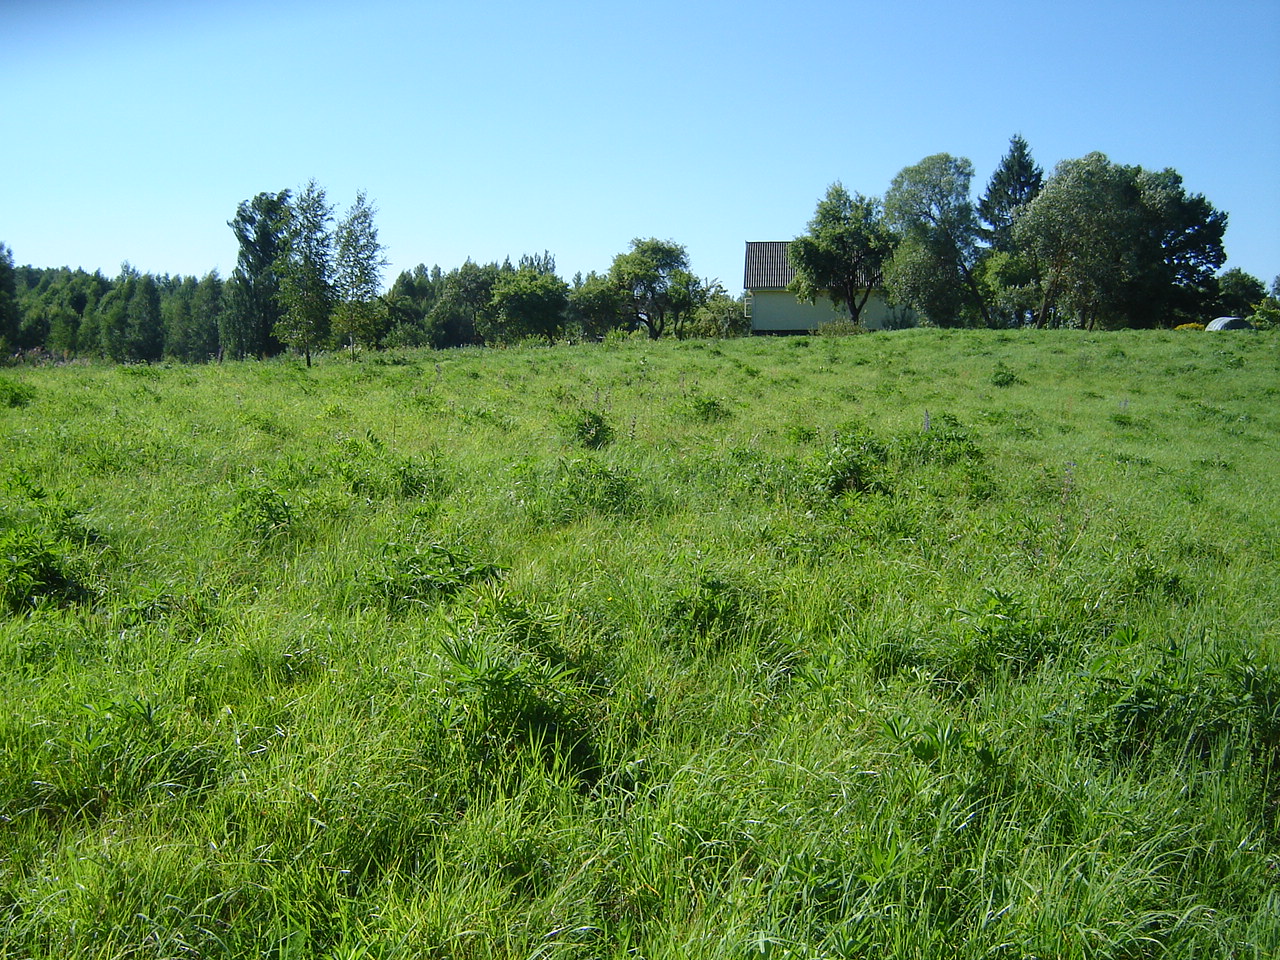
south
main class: Grassland
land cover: Grassland without tree/shrub cover
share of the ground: > 75 %
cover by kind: herbaceous plants 100 %
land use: Agriculture (excluding fallow land and kitchen gardens)
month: August
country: LT
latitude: 54.9763
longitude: 25.3876
